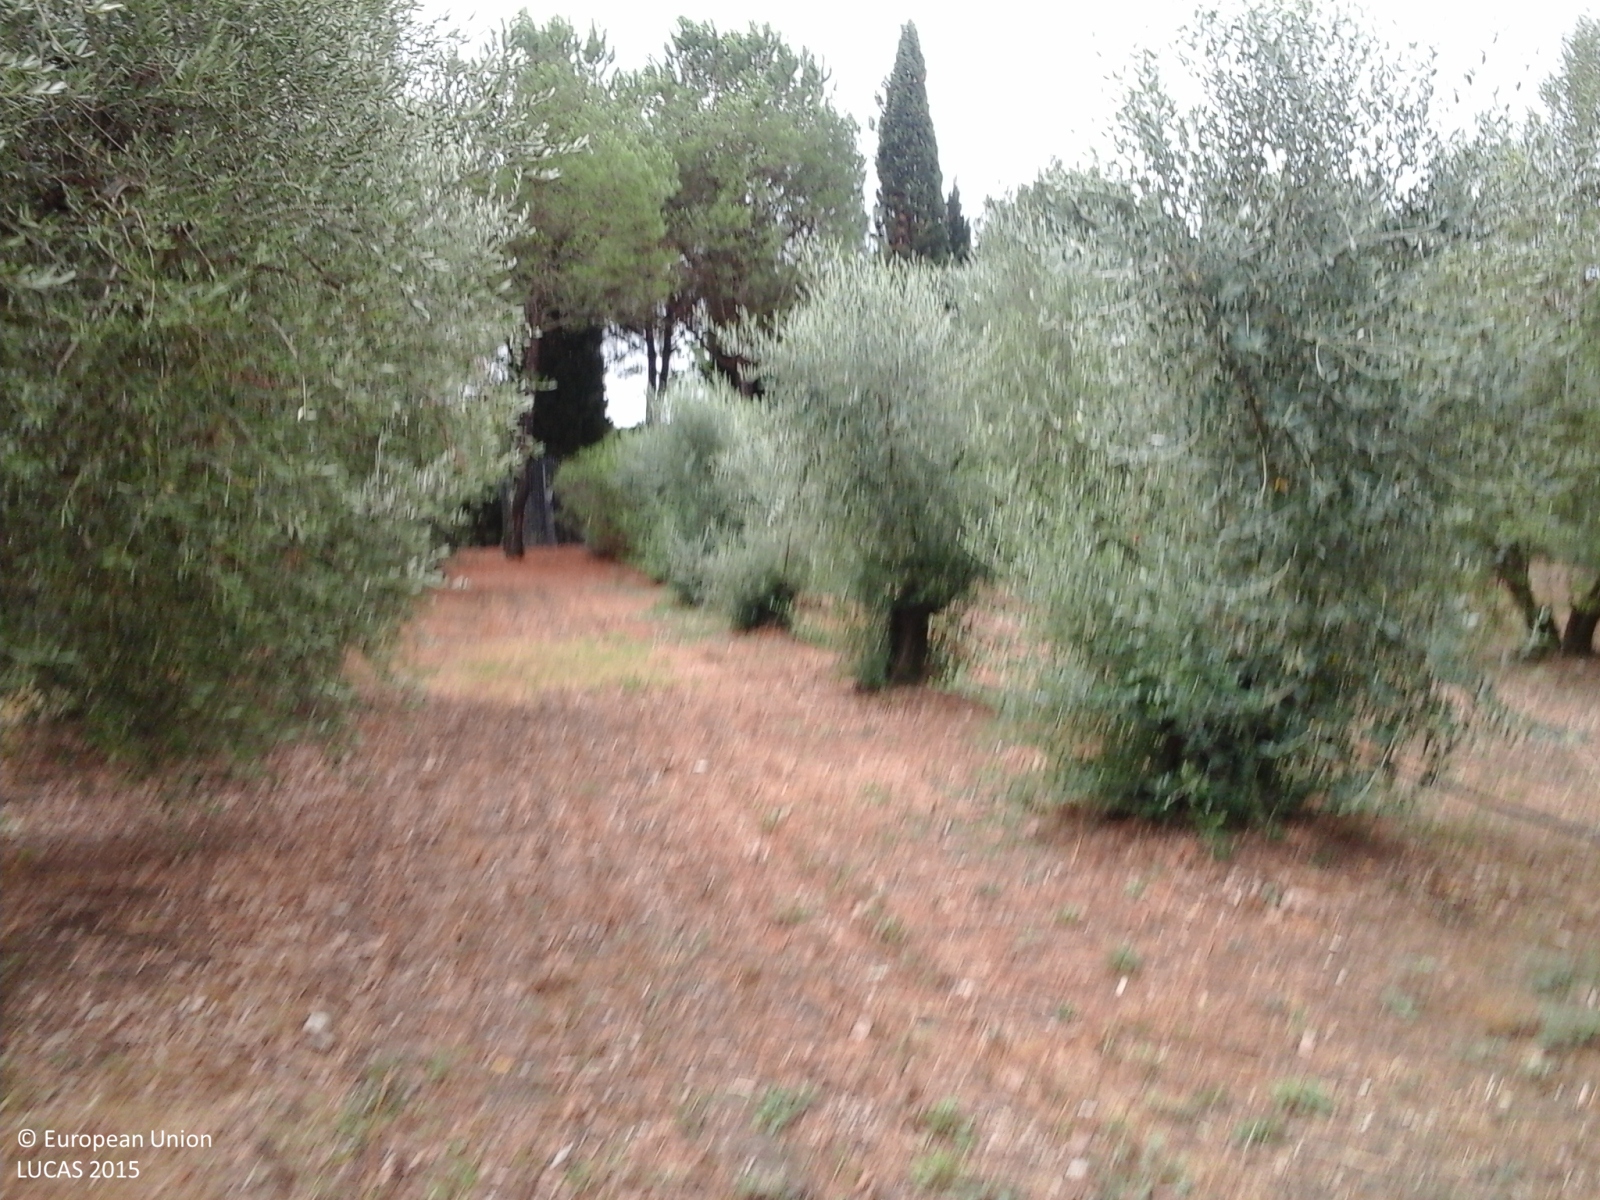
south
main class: Cropland
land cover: Olive groves
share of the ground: 50 - 75 %
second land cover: Grassland without tree/shrub cover
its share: 10 - 25 %
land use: Agriculture (excluding fallow land and kitchen gardens)
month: August
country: IT
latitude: 42.8840
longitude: 10.9886
